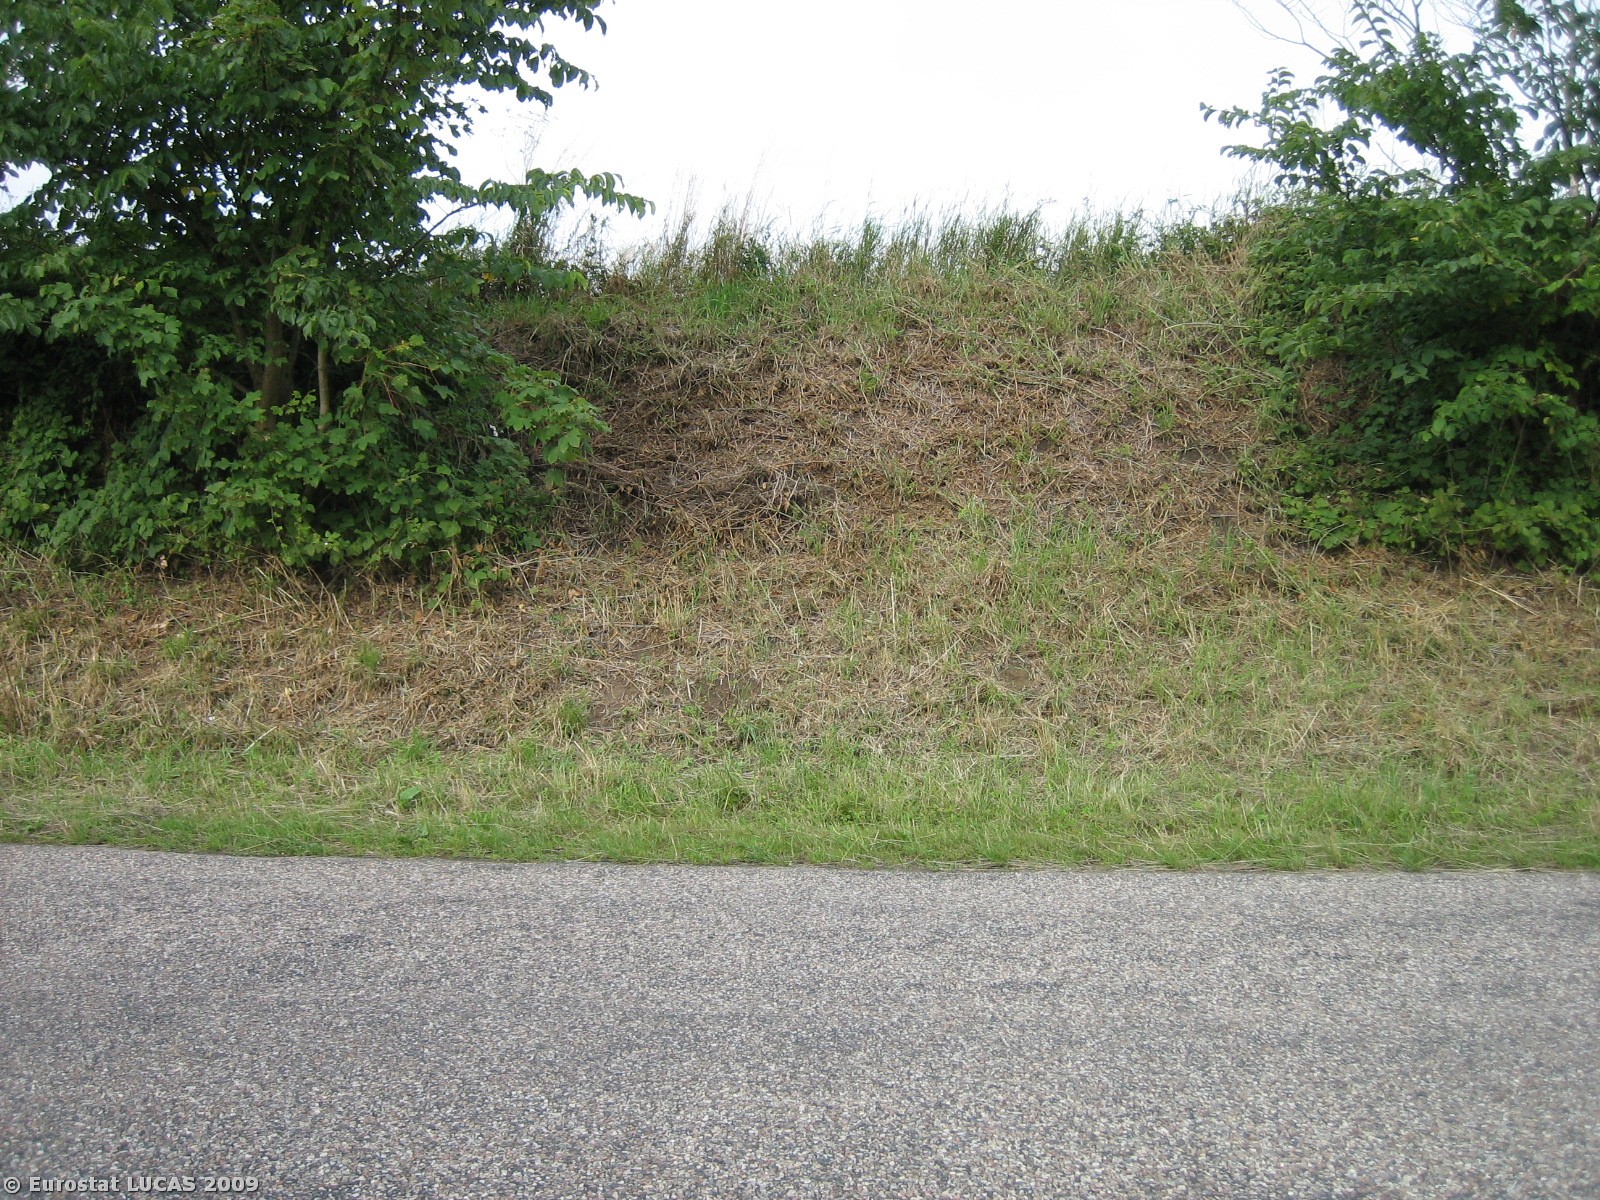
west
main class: Grassland
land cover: Grassland with sparse tree/shrub cover
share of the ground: > 75 %
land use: Unused
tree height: > 5 m
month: July
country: DK
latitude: 55.2171
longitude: 9.9843
